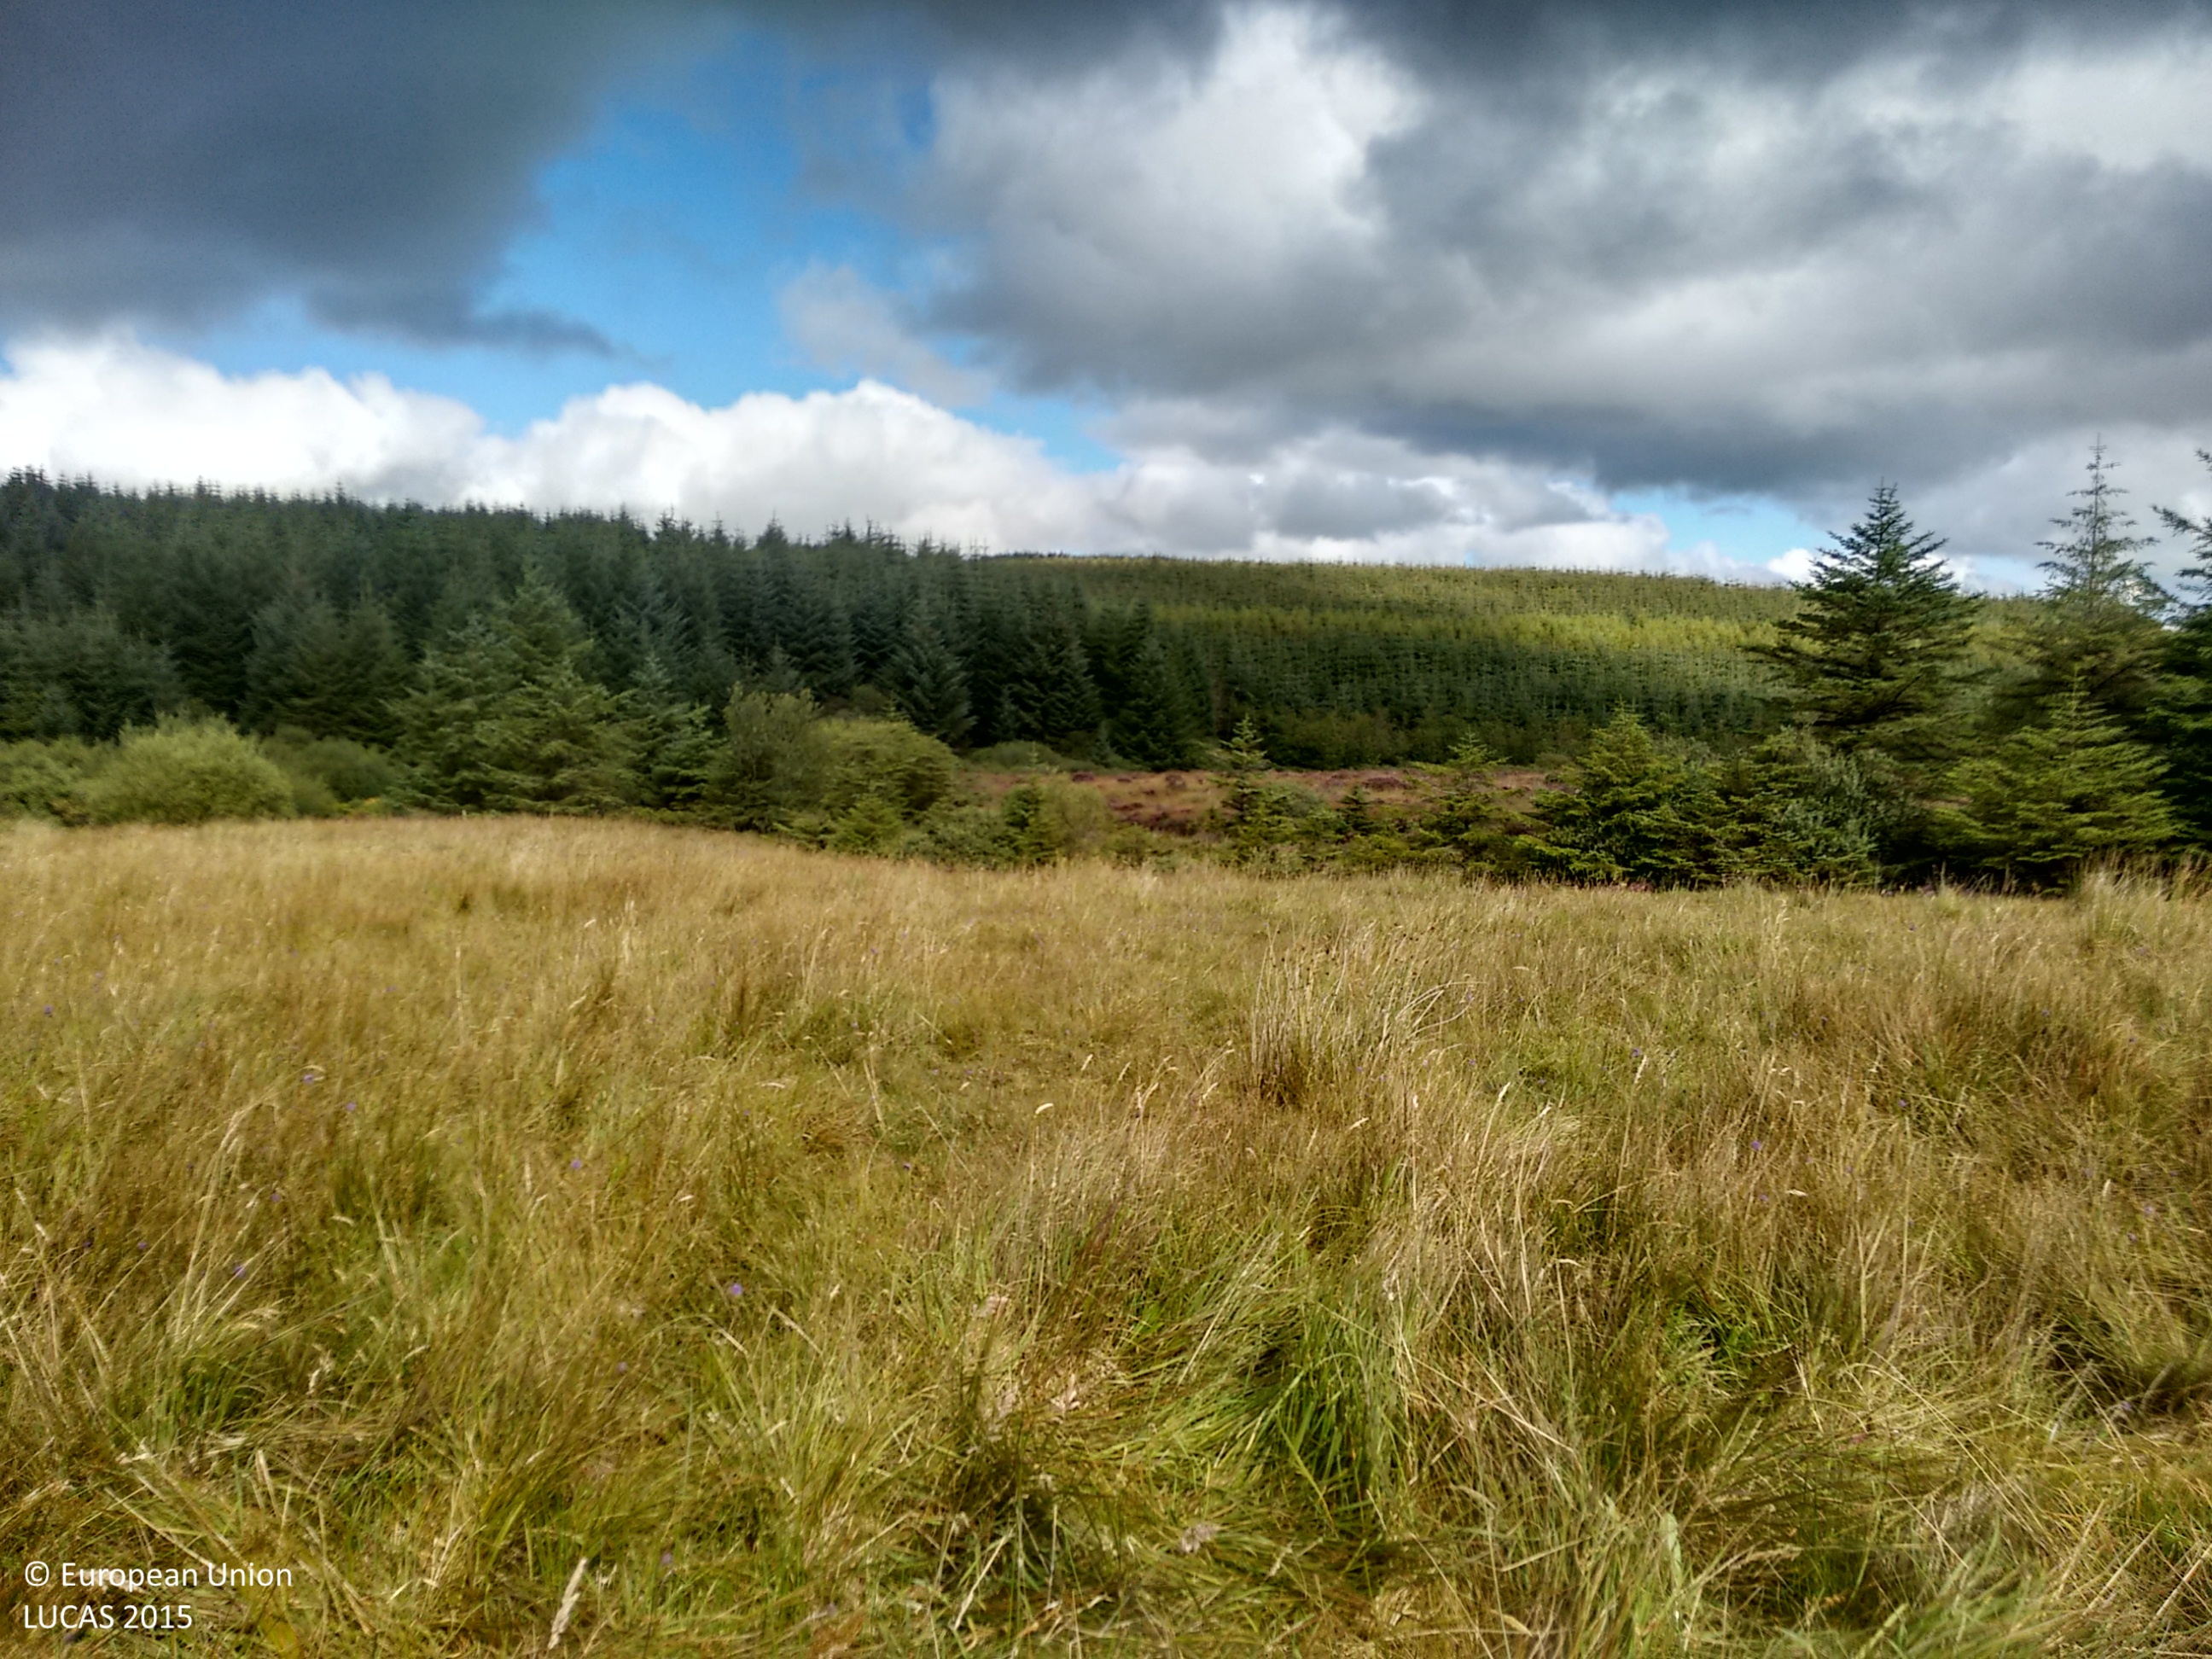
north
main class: Grassland
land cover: Grassland without tree/shrub cover
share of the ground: > 75 %
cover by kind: herbaceous plants 95 %, shrubs 5 %
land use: Agriculture (excluding fallow land and kitchen gardens)
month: September
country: IE
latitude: 52.2755
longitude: -9.3839
